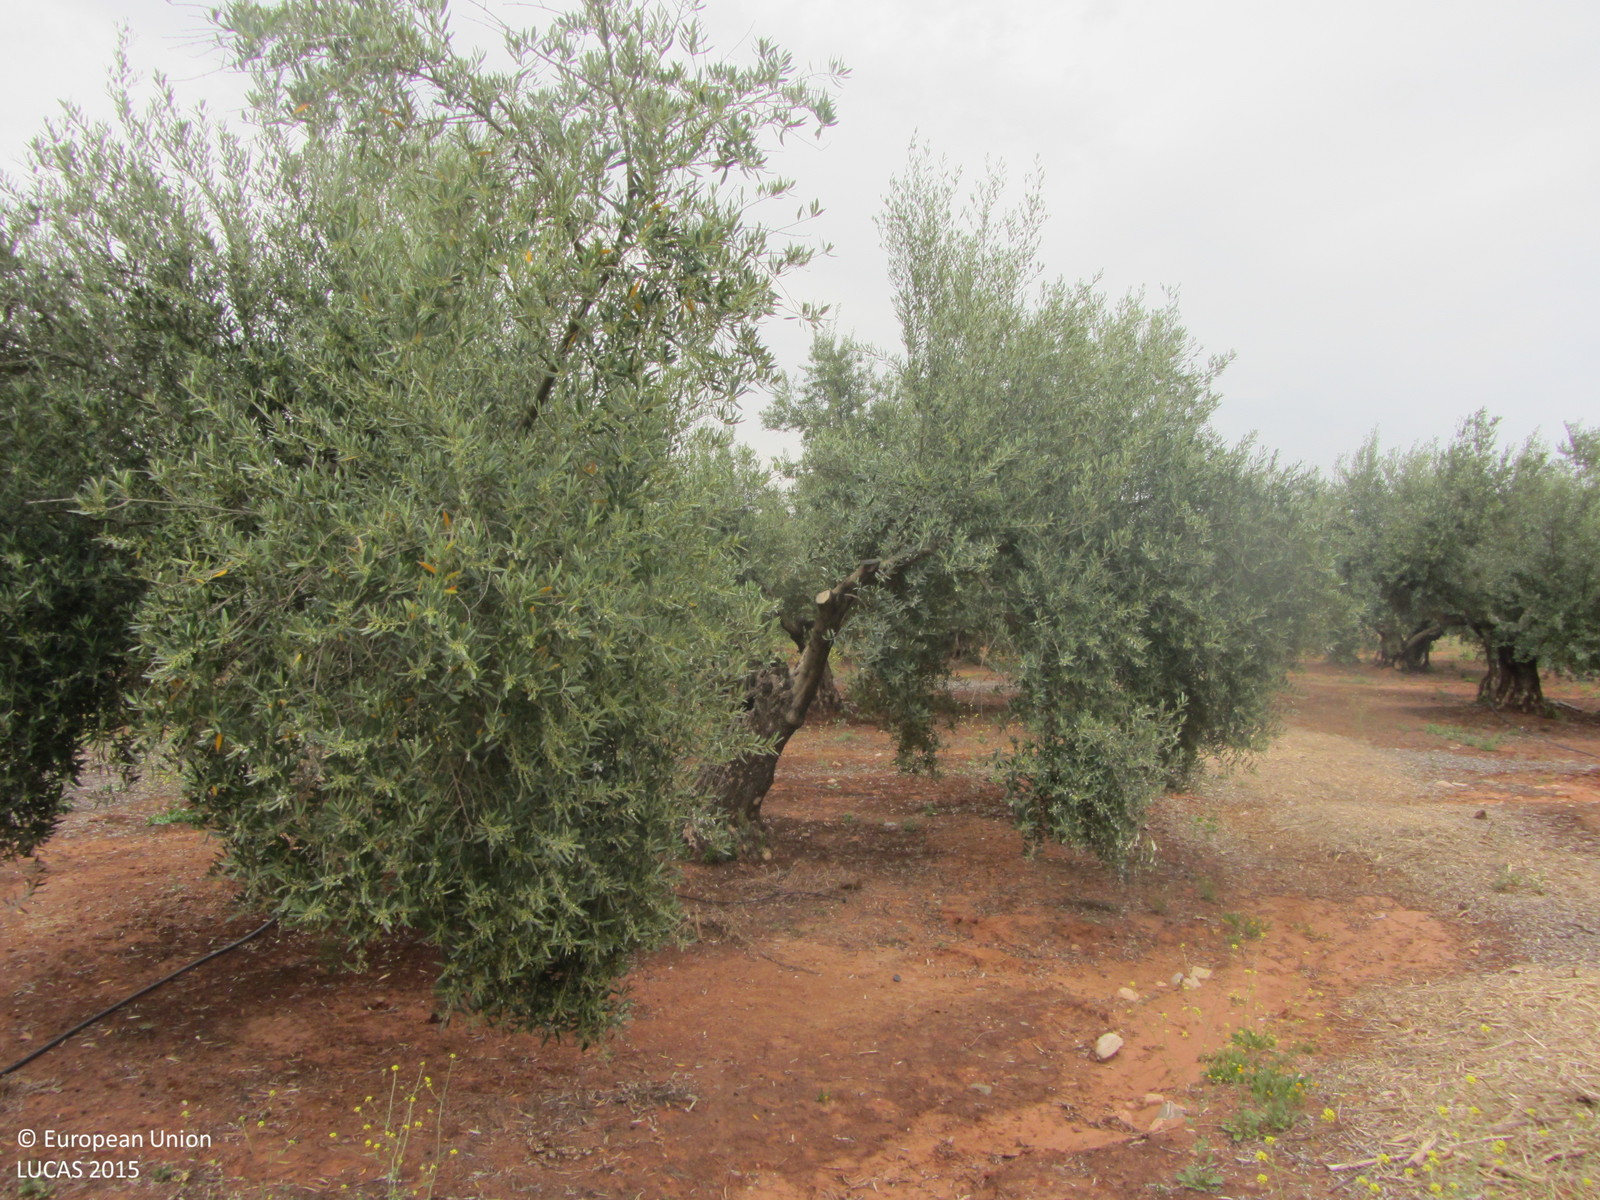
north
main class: Cropland
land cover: Olive groves
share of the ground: 25 - 50 %
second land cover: Other bare soil
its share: > 75 %
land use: Agriculture (excluding fallow land and kitchen gardens)
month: May
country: ES
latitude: 38.2427
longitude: -3.0139
